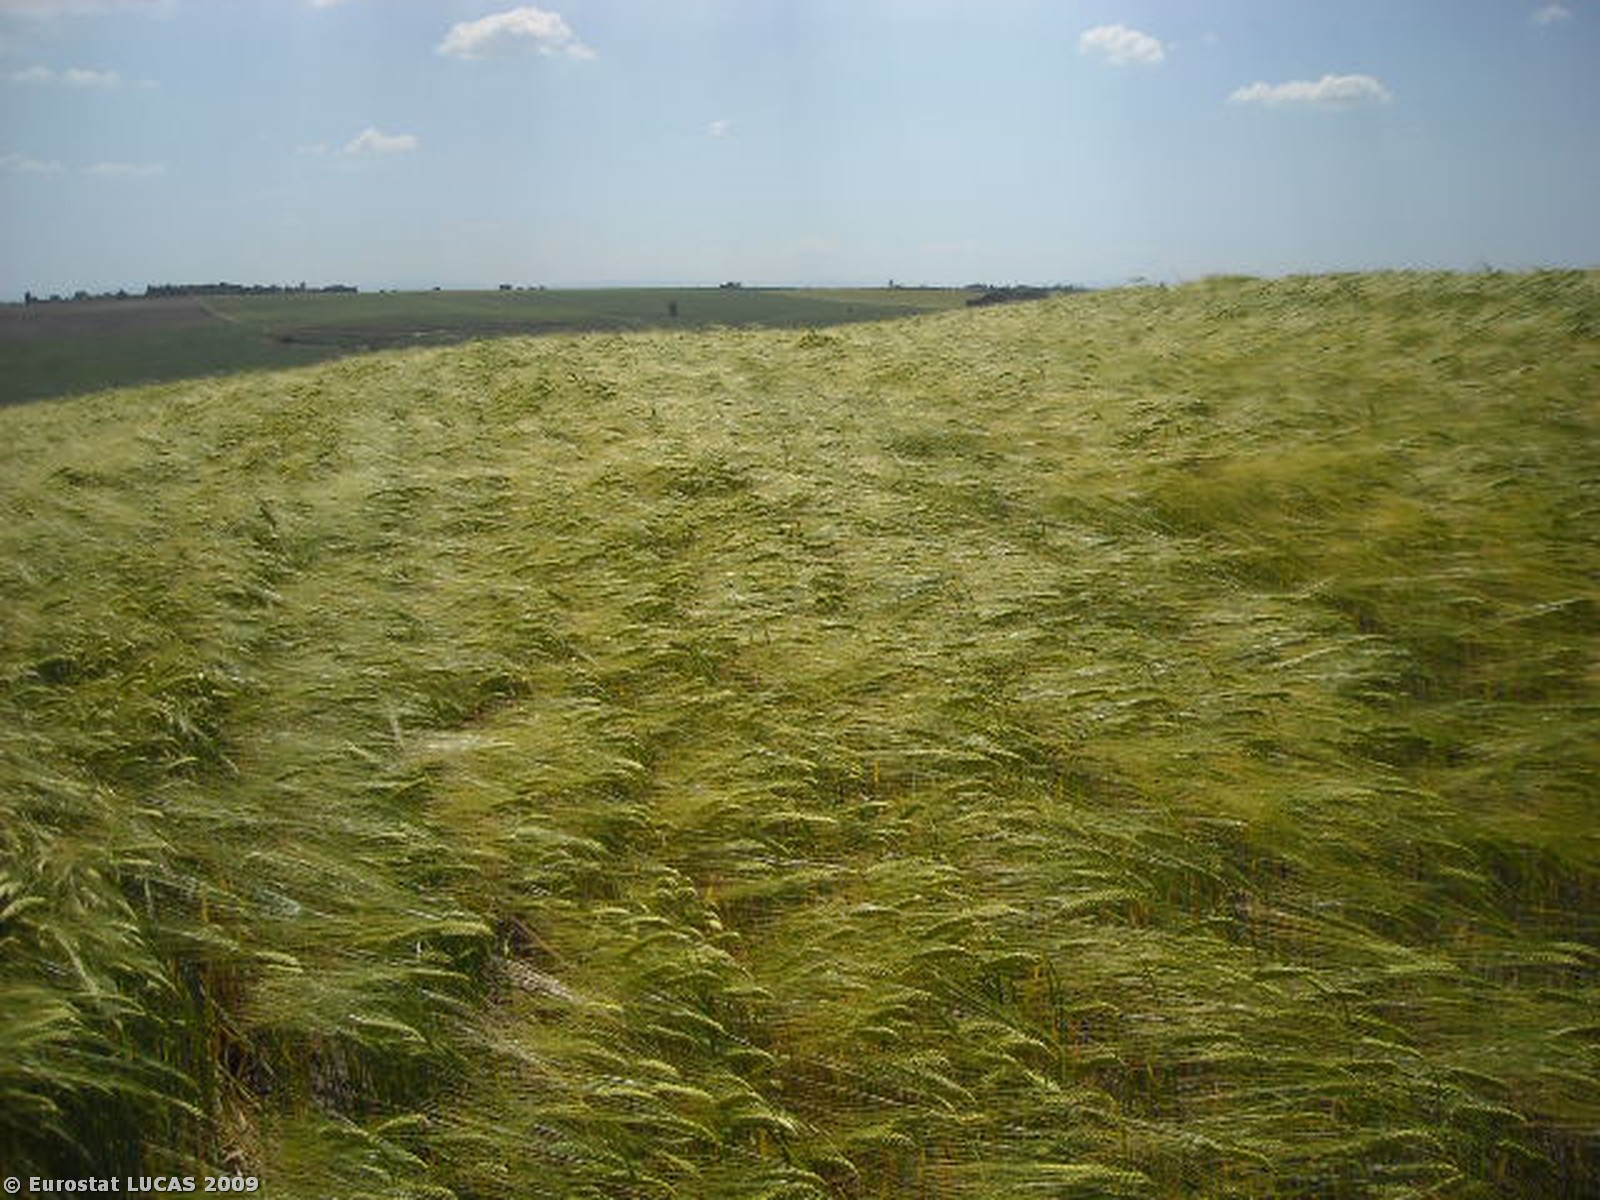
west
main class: Cropland
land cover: Barley
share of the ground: > 75 %
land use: Agriculture (excluding fallow land and kitchen gardens)
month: May
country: IT
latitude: 40.8974
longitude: 16.3289
